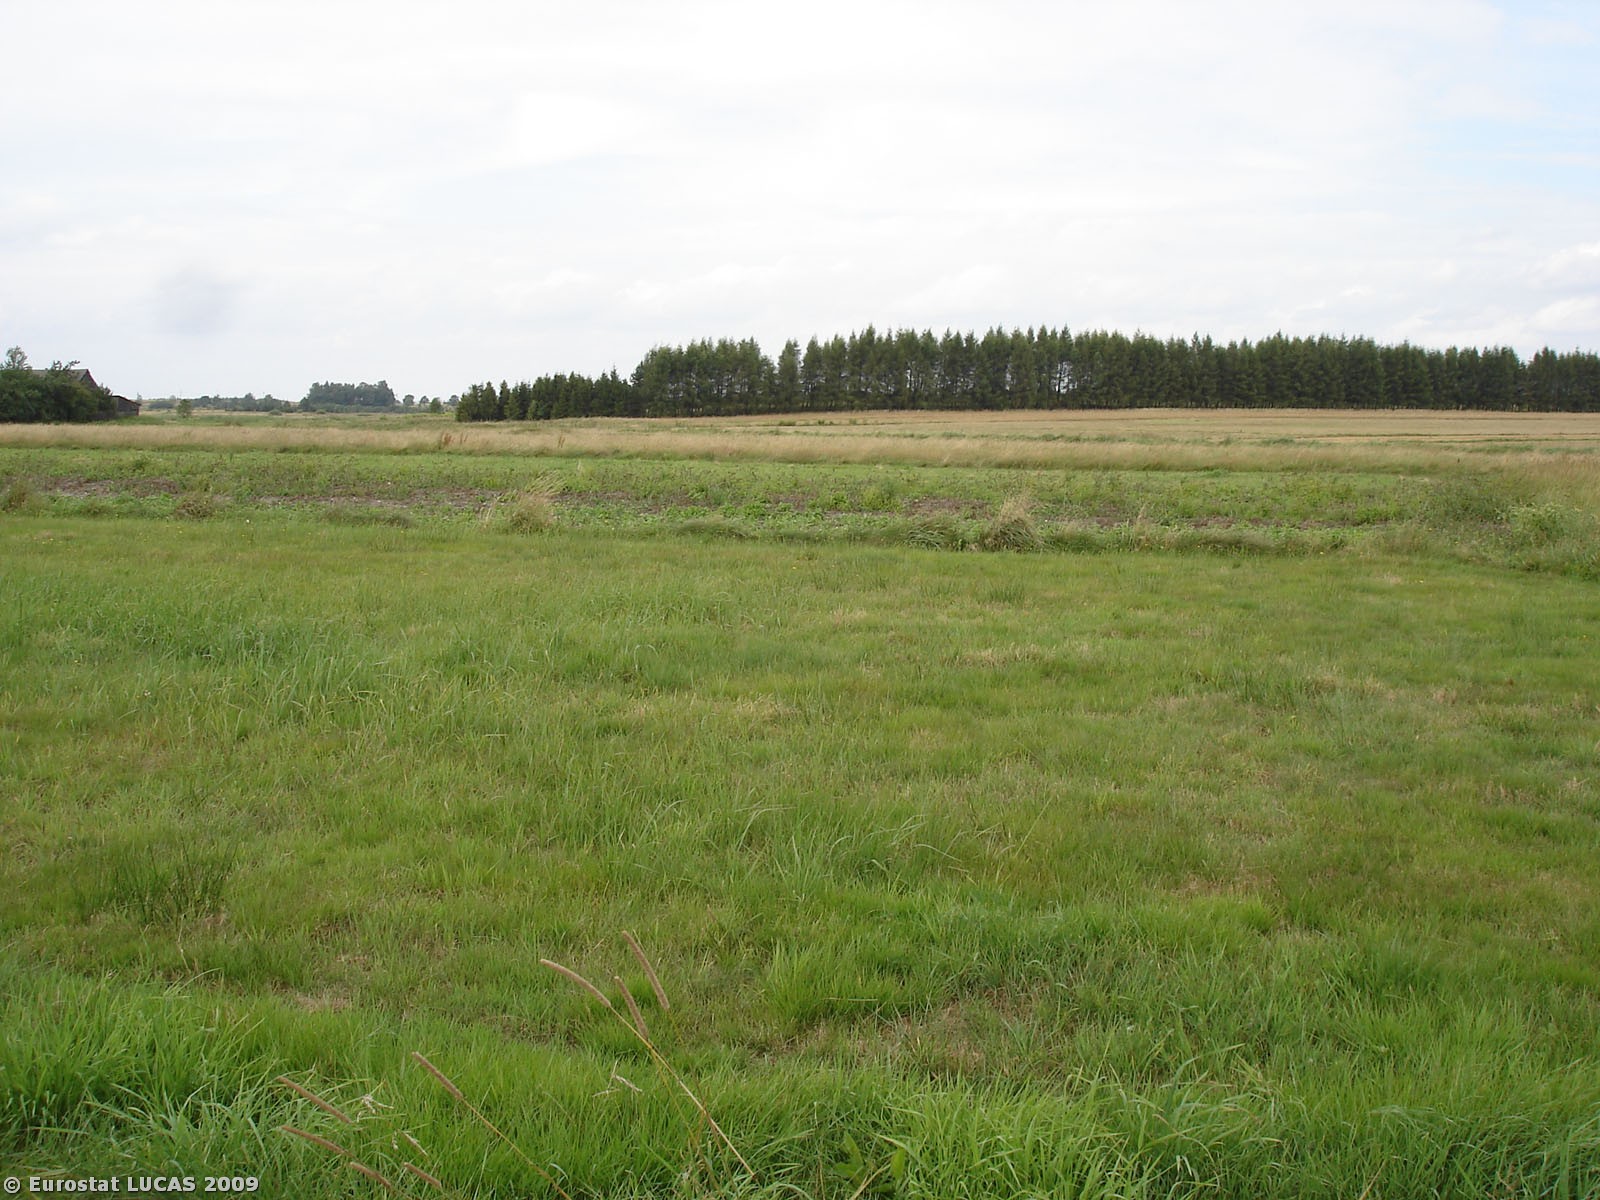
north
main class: Grassland
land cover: Grassland without tree/shrub cover
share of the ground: > 75 %
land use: Agriculture (excluding fallow land and kitchen gardens)
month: August
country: PL
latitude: 50.8175
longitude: 18.8364
